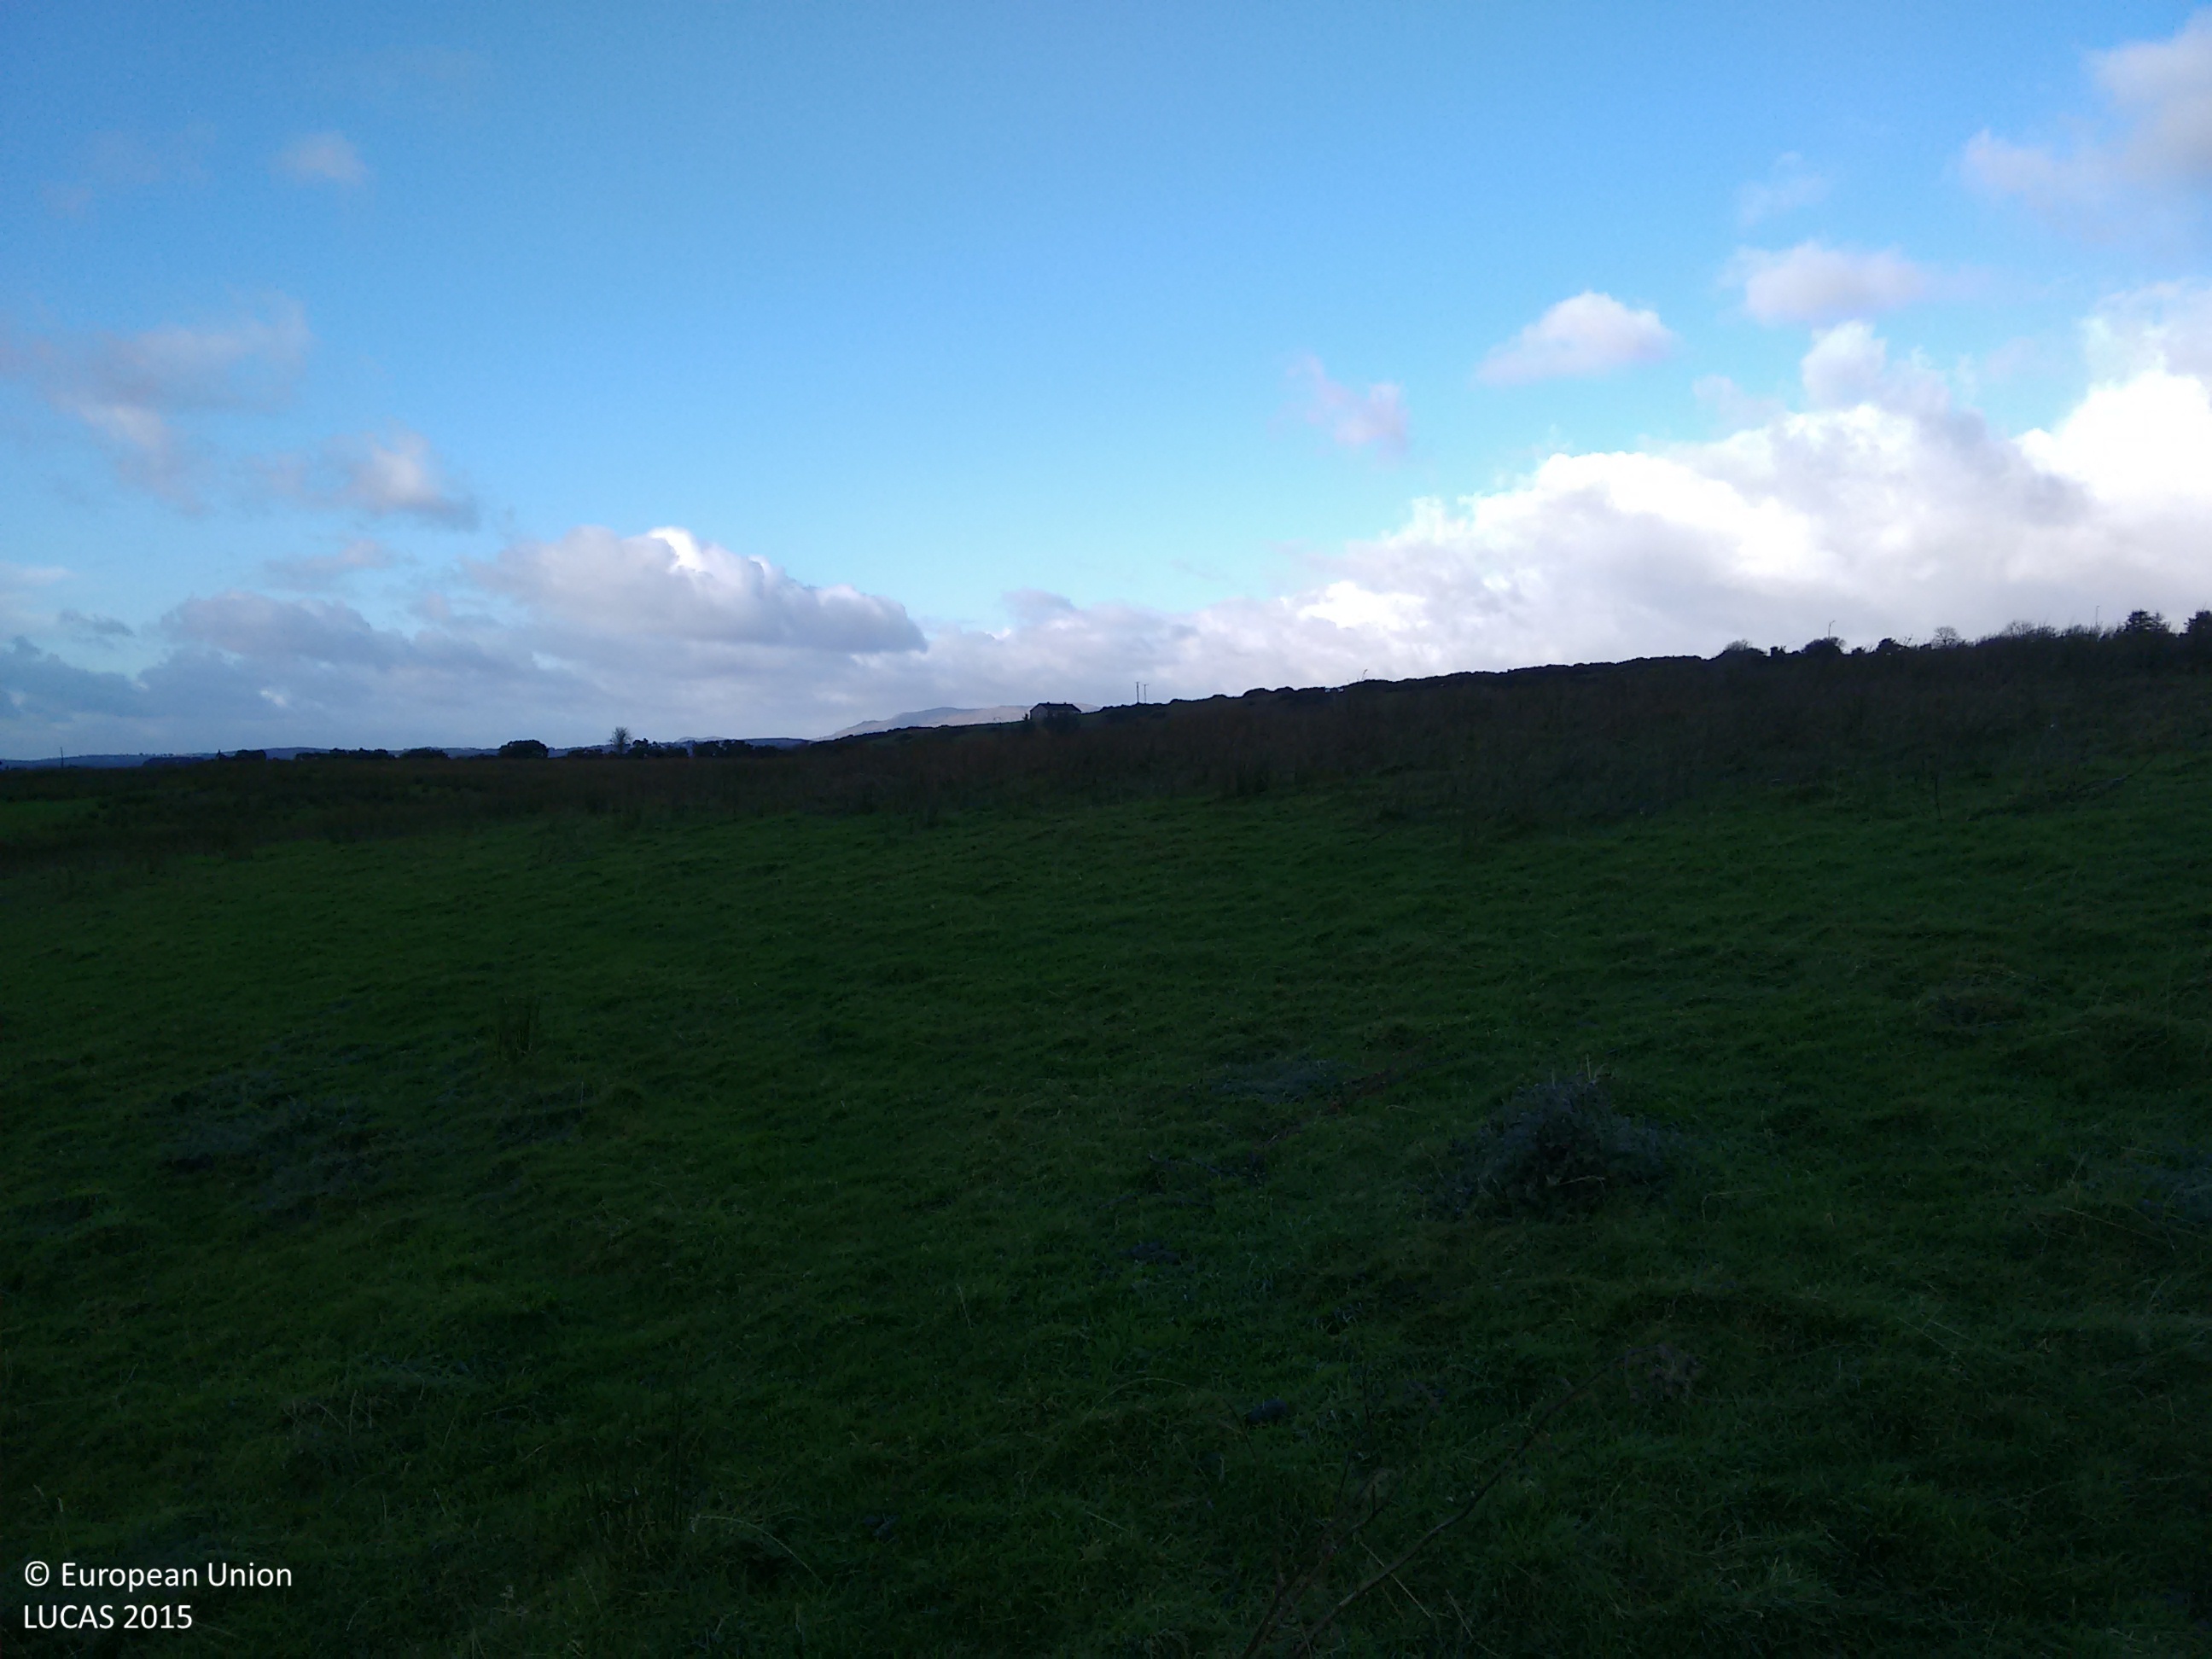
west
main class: Grassland
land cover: Grassland without tree/shrub cover
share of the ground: > 75 %
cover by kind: herbaceous plants 100 %
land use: Agriculture (excluding fallow land and kitchen gardens)
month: November
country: IE
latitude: 54.6373
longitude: -8.2628
